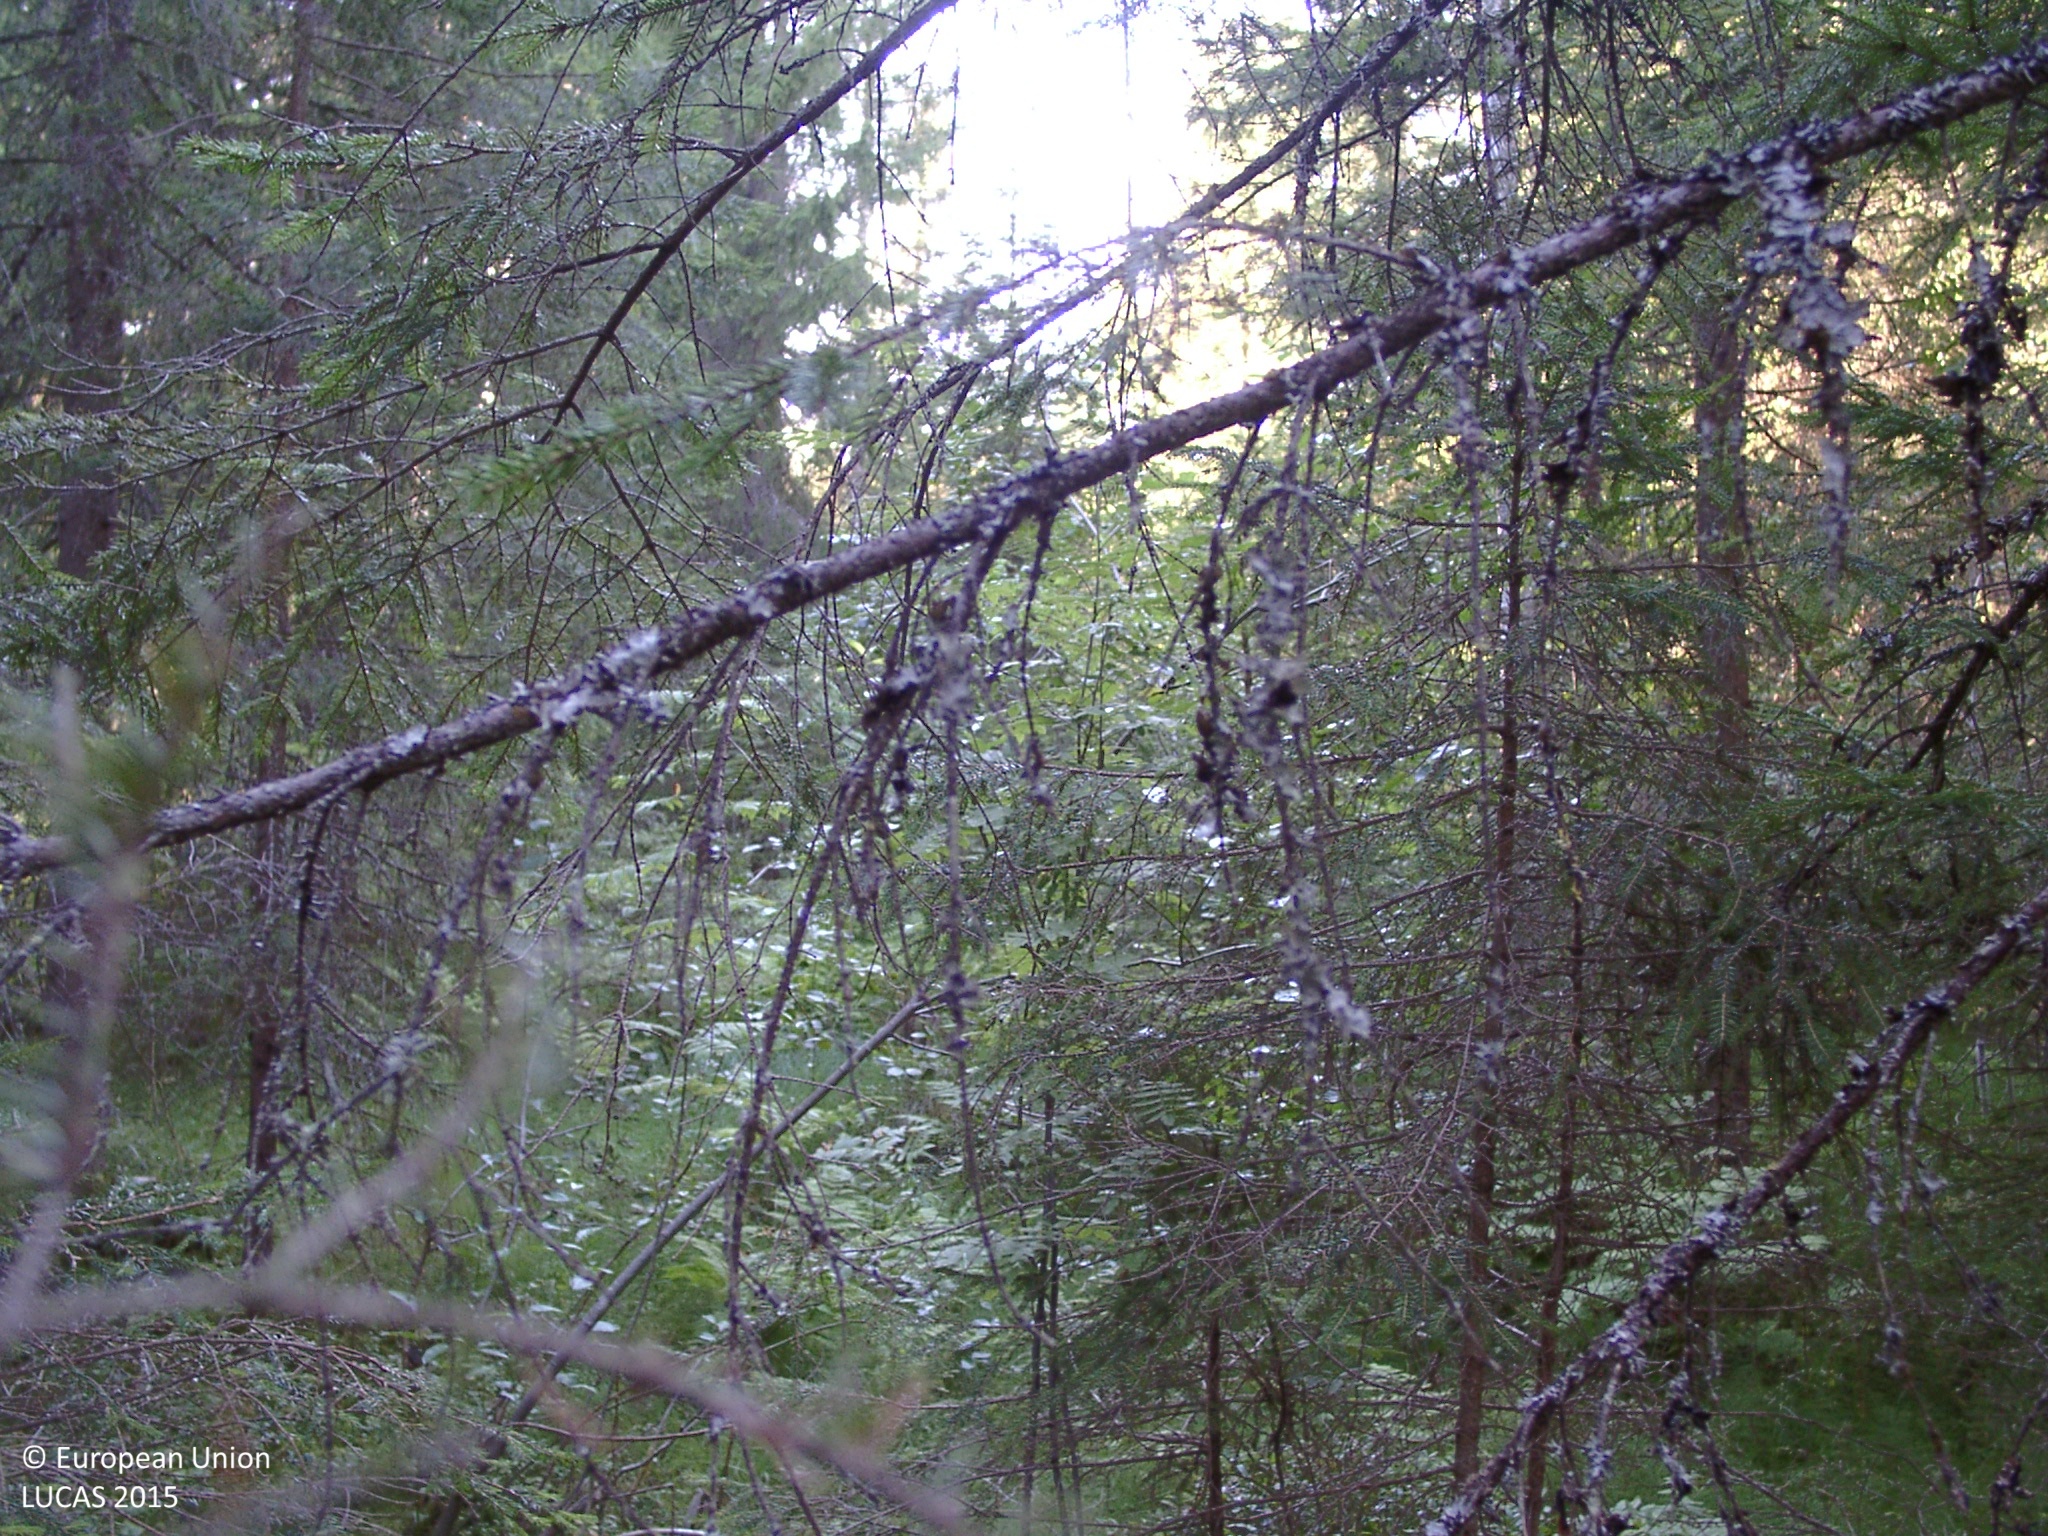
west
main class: Woodland
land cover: Spruce dominated coniferous woodland
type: boreal forest
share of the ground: > 75 %
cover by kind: coniferous forest trees 65 %, broadleaved forest trees 10 %, herbaceous plants 10 %, lichens and mosses 10 %, shrubs 5 %
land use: Forestry
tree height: > 5 m
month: August
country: FI
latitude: 62.4345
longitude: 25.2739
